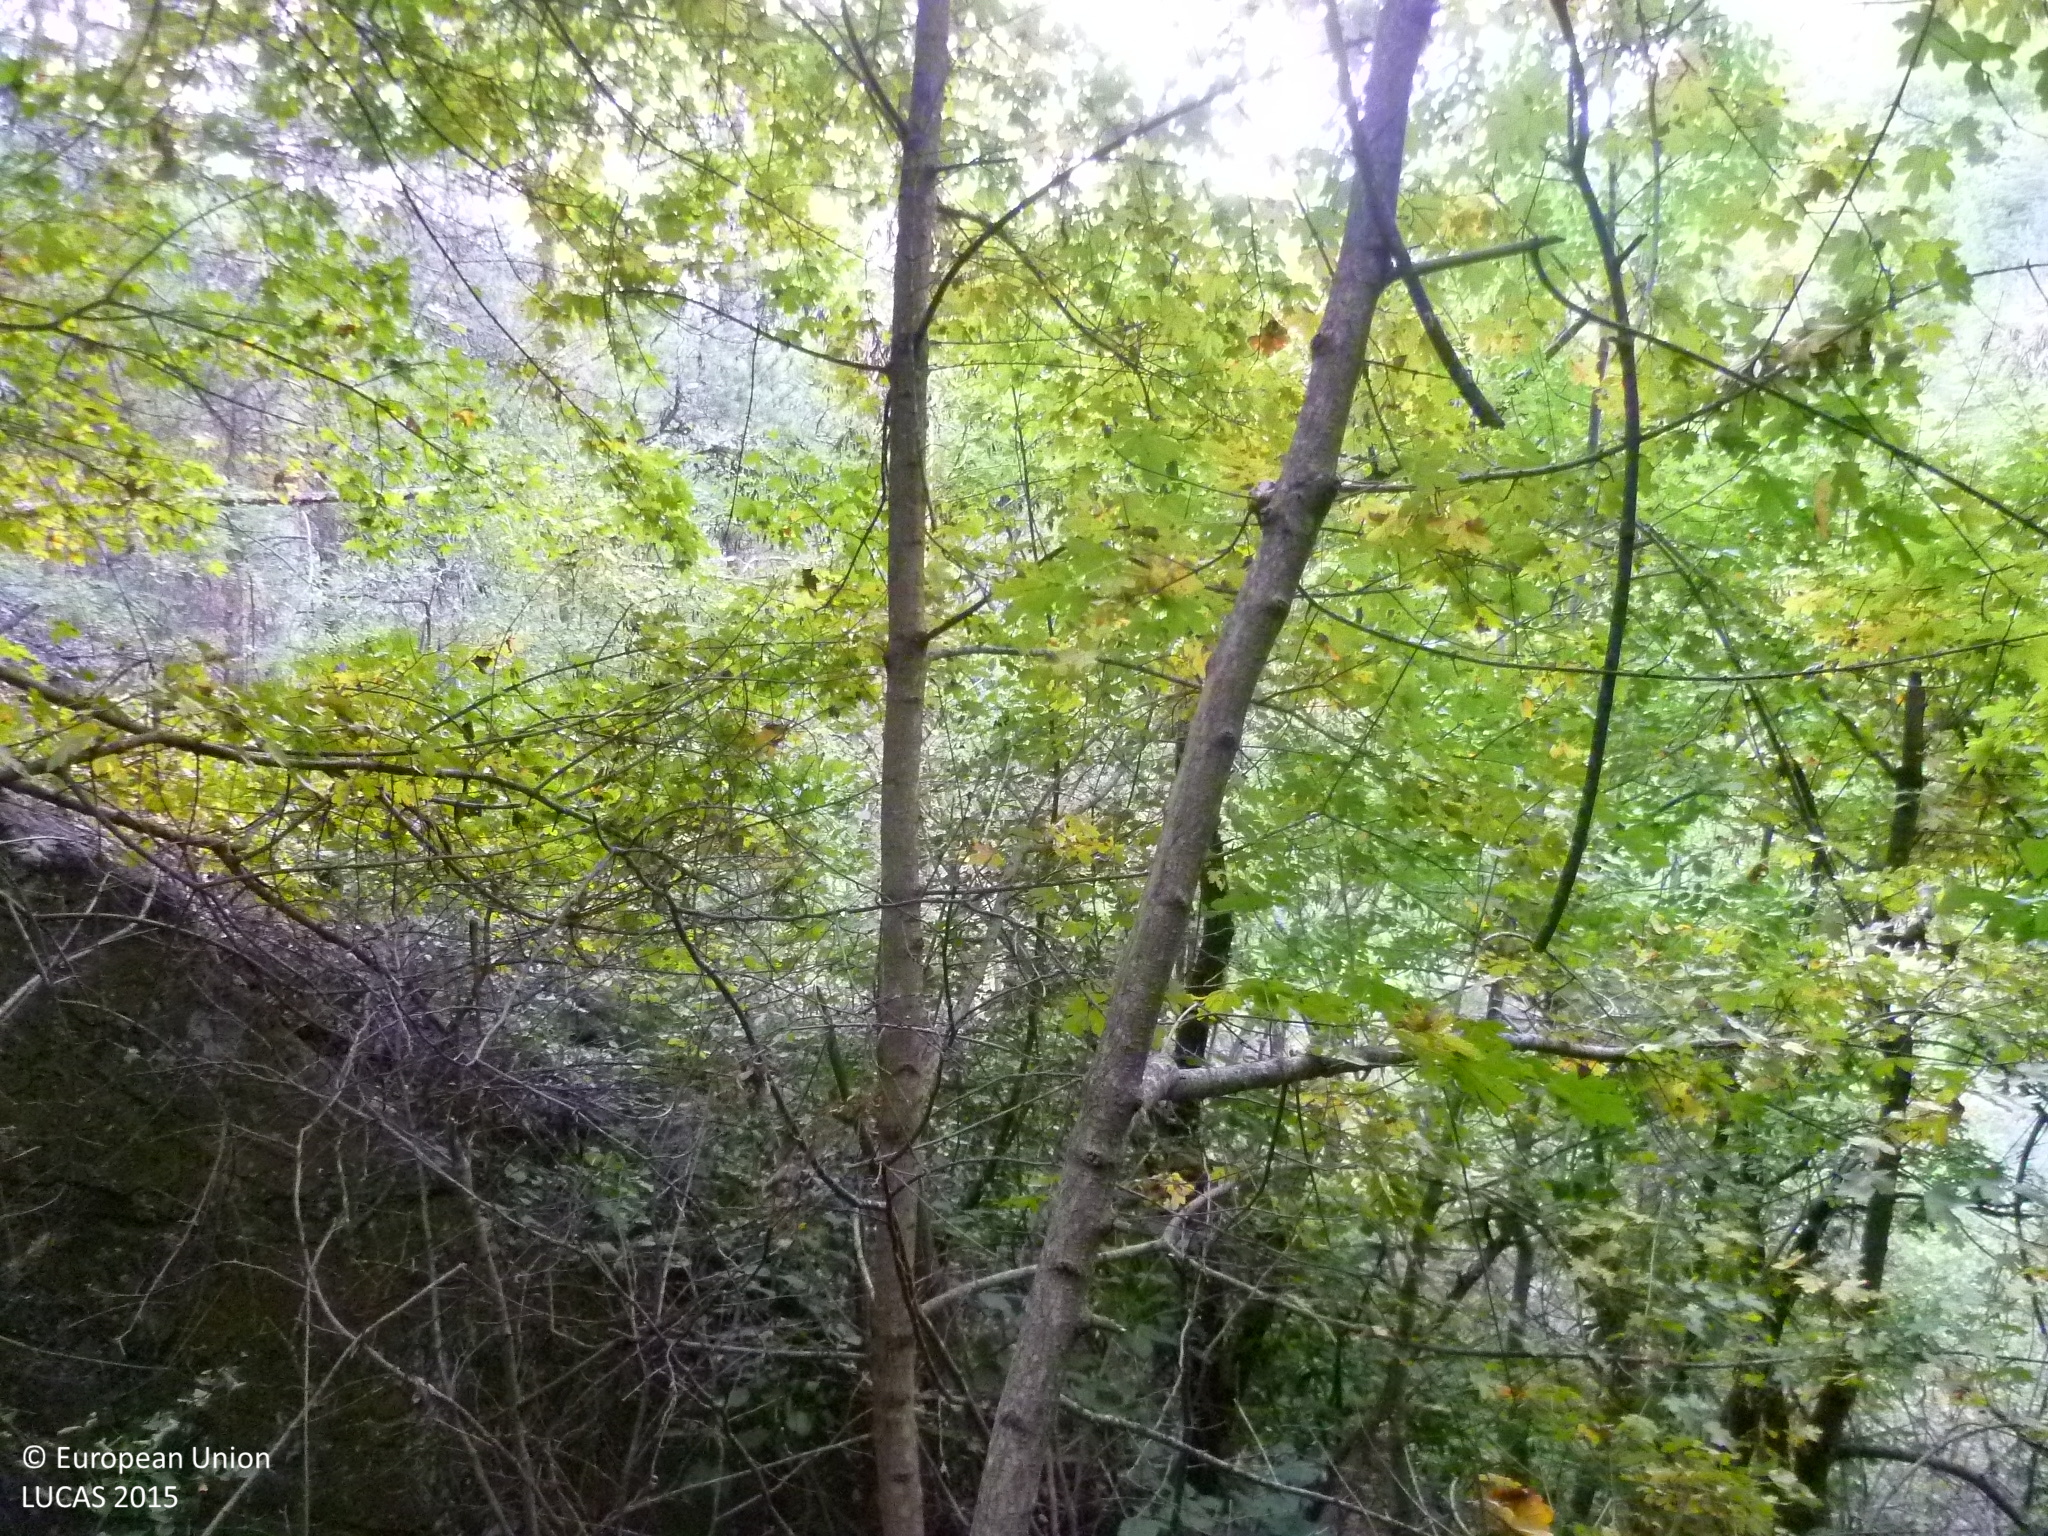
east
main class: Woodland
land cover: Pine dominated mixed woodland
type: mesophytic deciduous forest
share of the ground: > 75 %
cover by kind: coniferous forest trees 60 %, broadleaved forest trees 20 %, unconsolidated bare surface 20 %
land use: Forestry
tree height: > 5 m
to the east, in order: Pine dominated mixed woodland; Rivers and streams; Broadleaved woodland; Tracks; Pine dominated mixed woodland; Tracks; Pine dominated mixed woodland
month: October
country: BG
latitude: 42.7224
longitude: 22.7391
